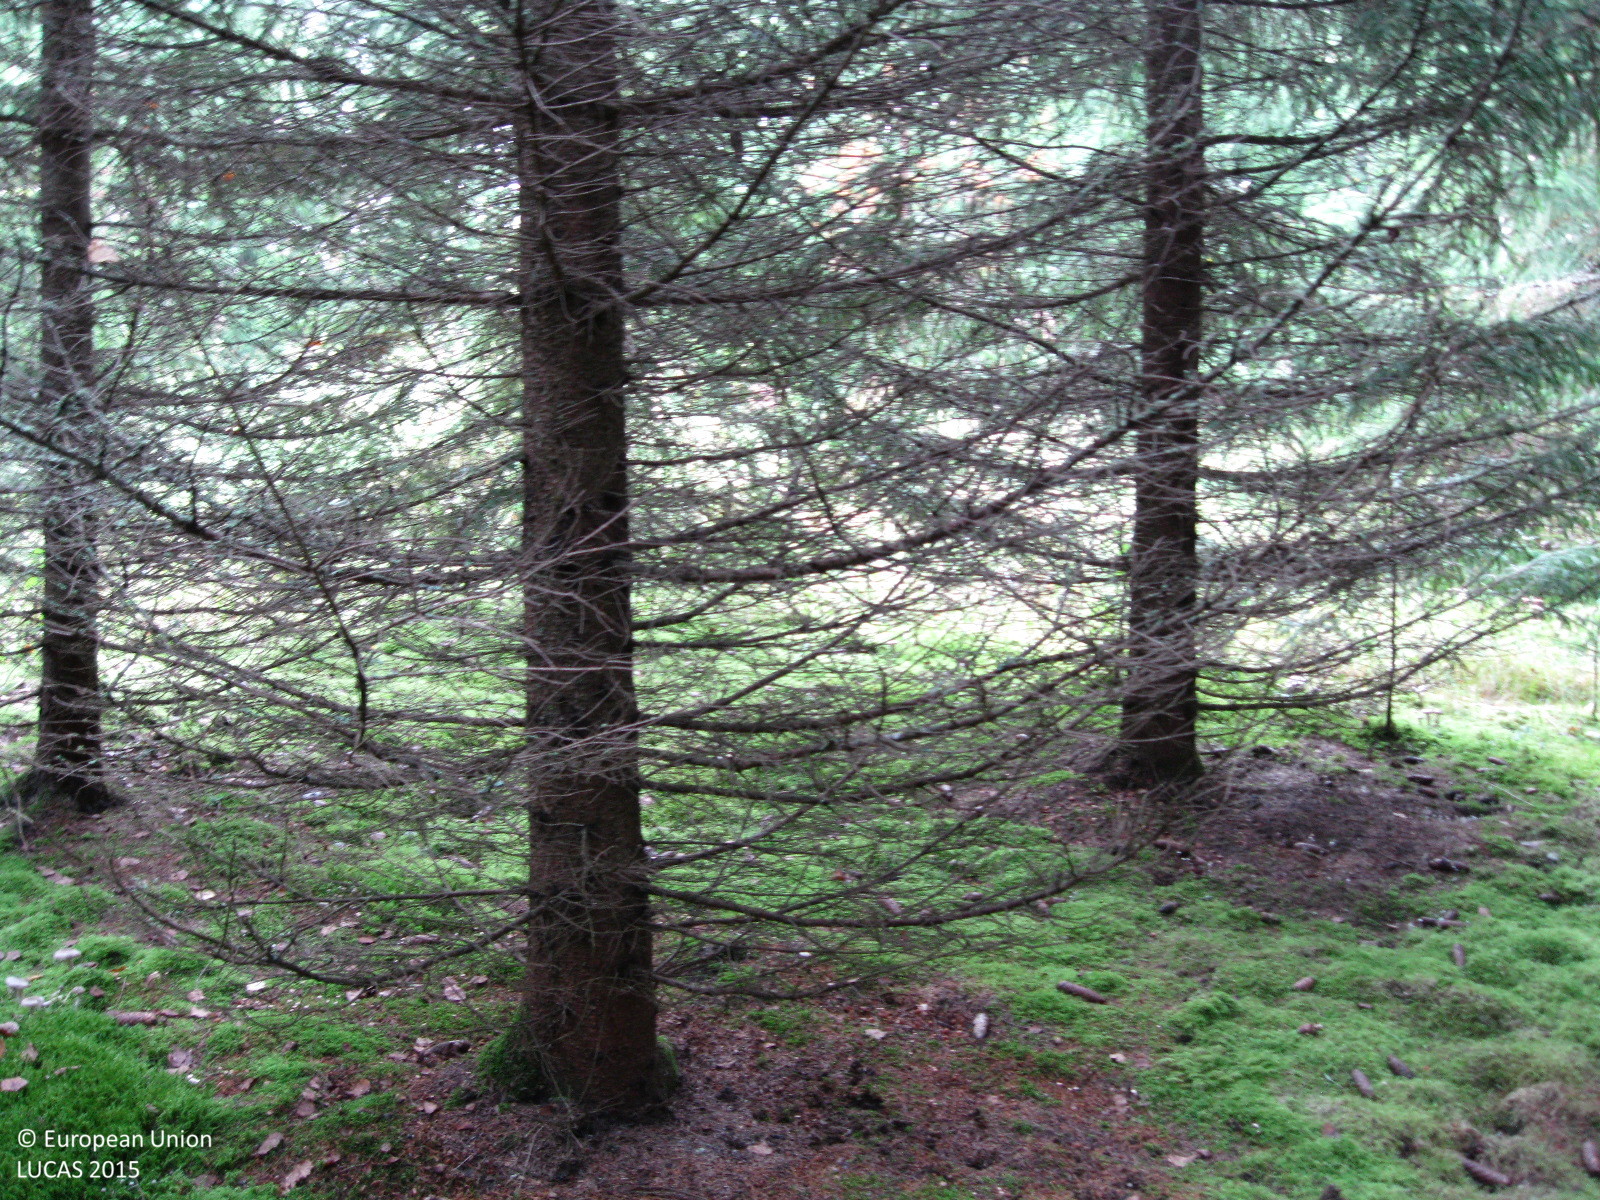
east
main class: Woodland
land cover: Spruce dominated coniferous woodland
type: boreal forest
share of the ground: > 75 %
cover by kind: coniferous forest trees 85 %, lichens and mosses 10 %, herbaceous plants 5 %
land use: Forestry
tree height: > 5 m
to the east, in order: Spruce dominated coniferous woodland; Grassland with sparse tree/shrub cover; Pine dominated coniferous woodland; Spruce dominated coniferous woodland; Grassland with sparse tree/shrub cover; Grassland without tree/shrub cover; Ditches and canals; Grass margins; Temporary grasslands; Electric lines; Temporary grasslands
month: September
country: FI
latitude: 60.3888
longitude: 24.2353
